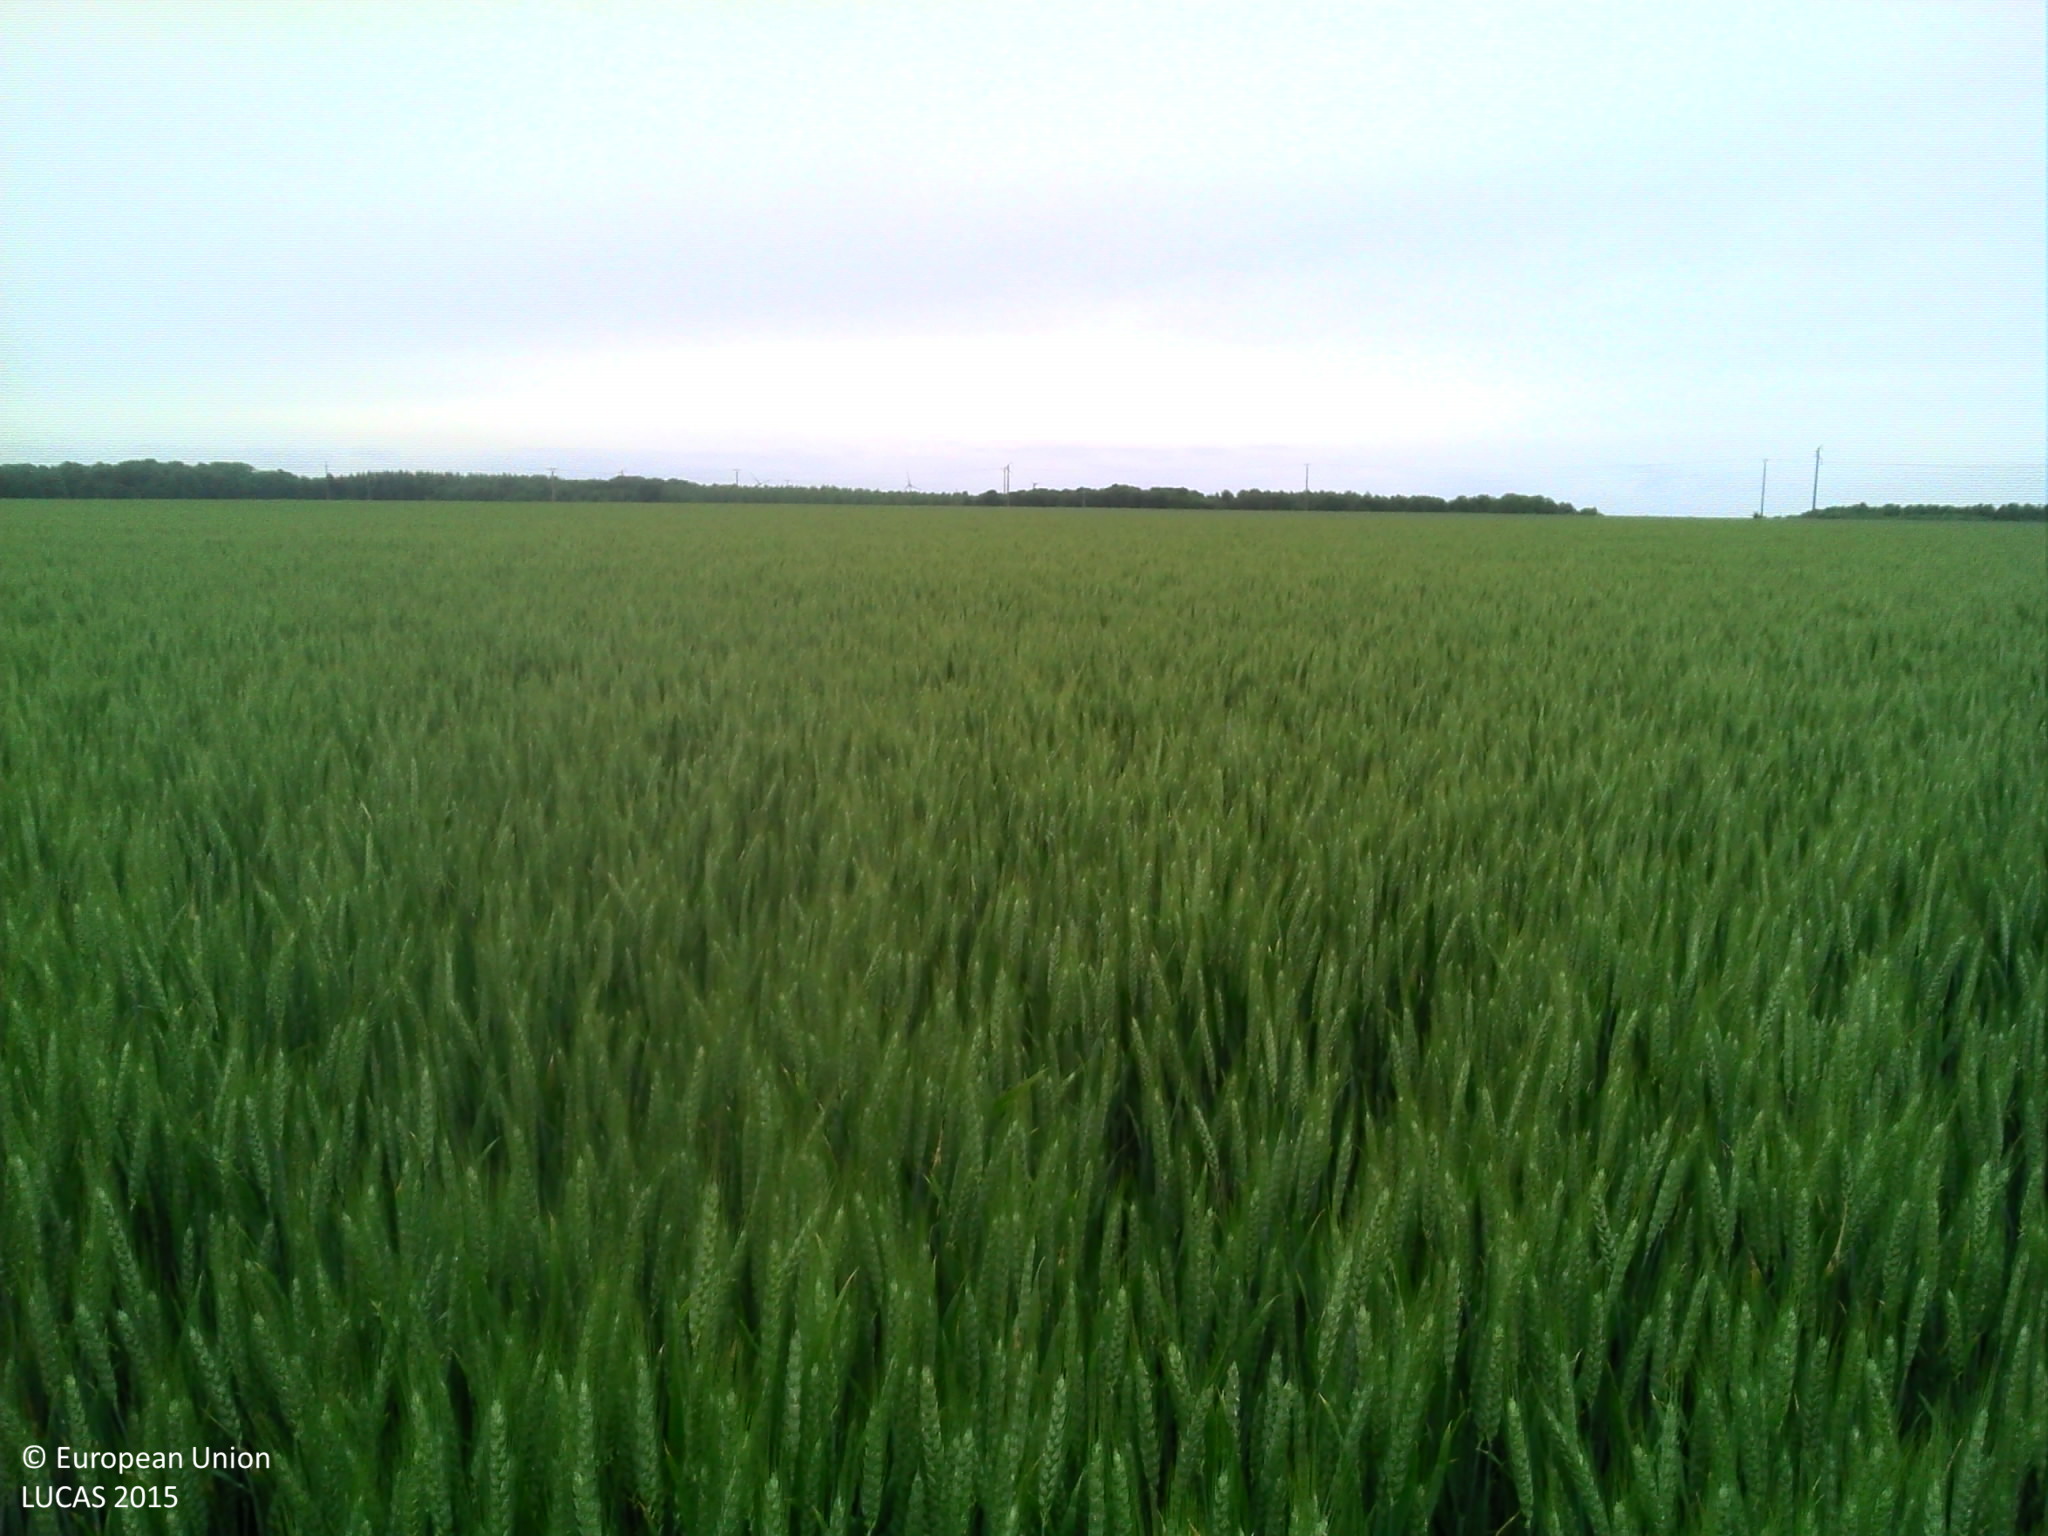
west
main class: Cropland
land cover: Durum wheat
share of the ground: > 75 %
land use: Agriculture (excluding fallow land and kitchen gardens)
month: June
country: FR
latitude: 49.8971
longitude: 2.1759
